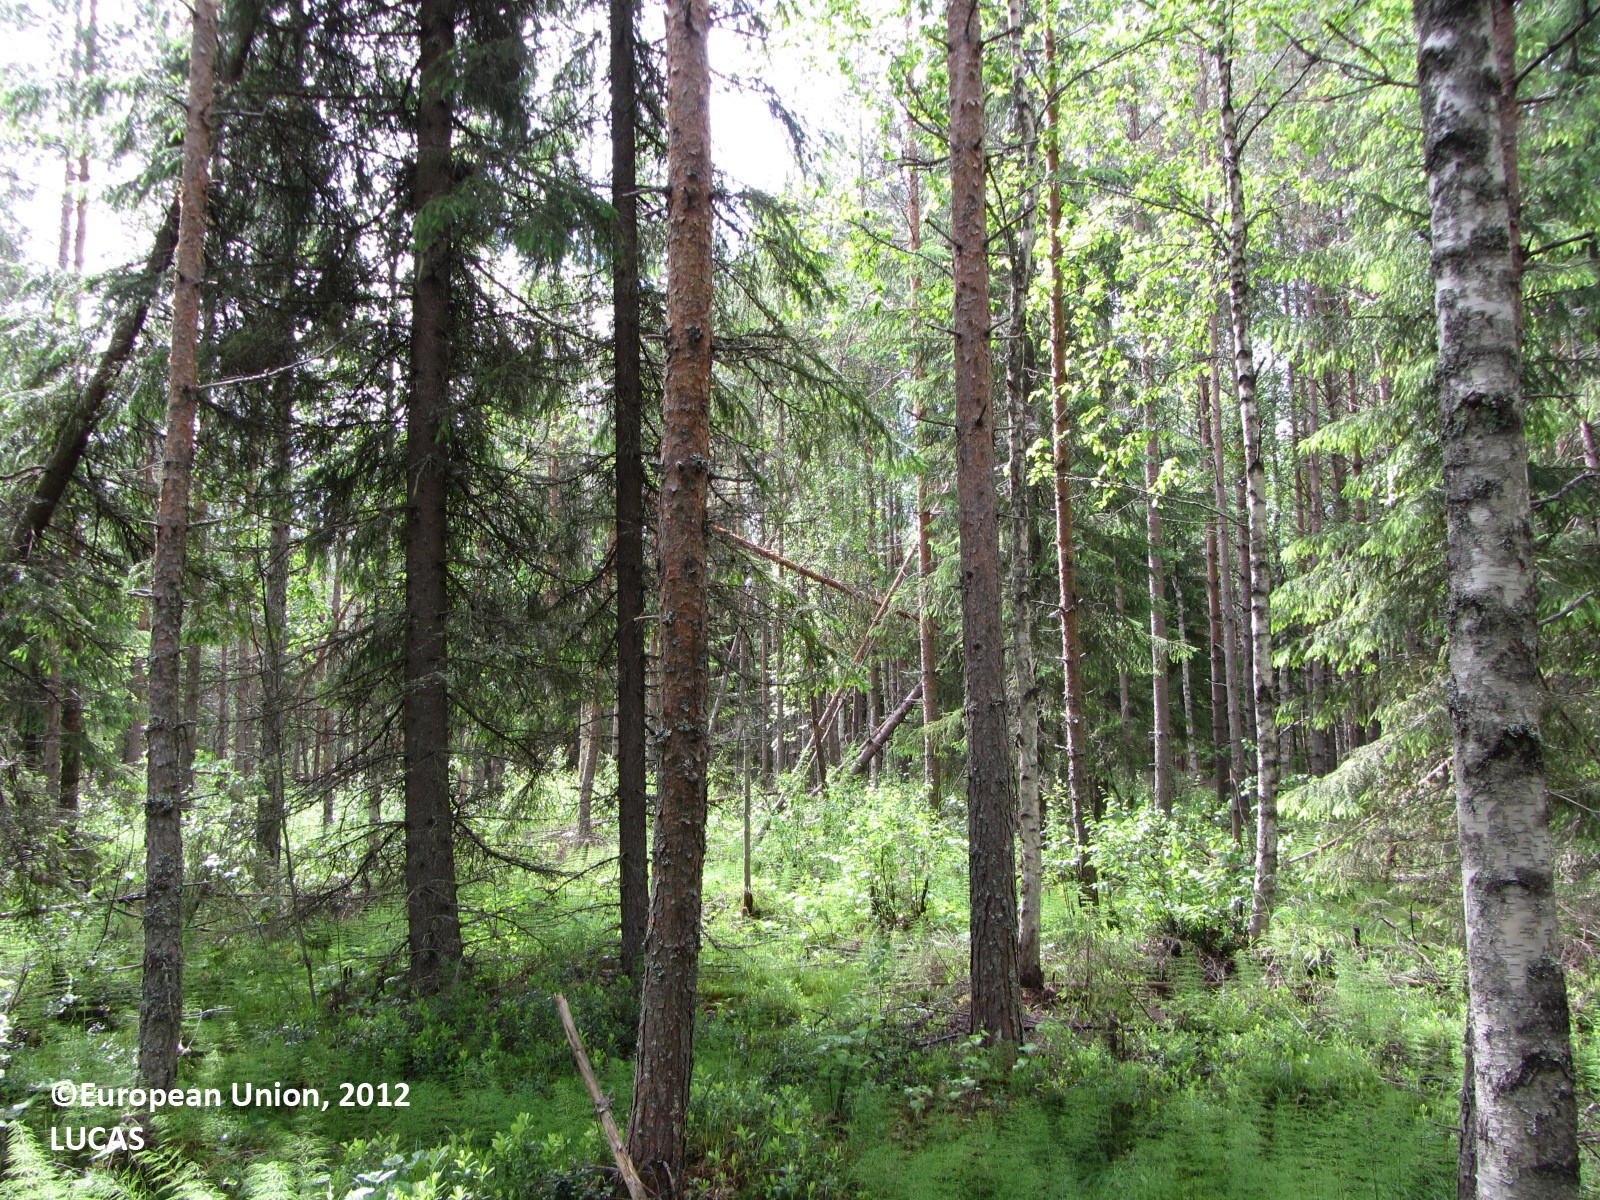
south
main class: Woodland
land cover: Other mixed woodland
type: boreal forest
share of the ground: > 75 %
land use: Forestry
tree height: > 5 m
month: June
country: FI
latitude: 62.6270
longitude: 25.0134
